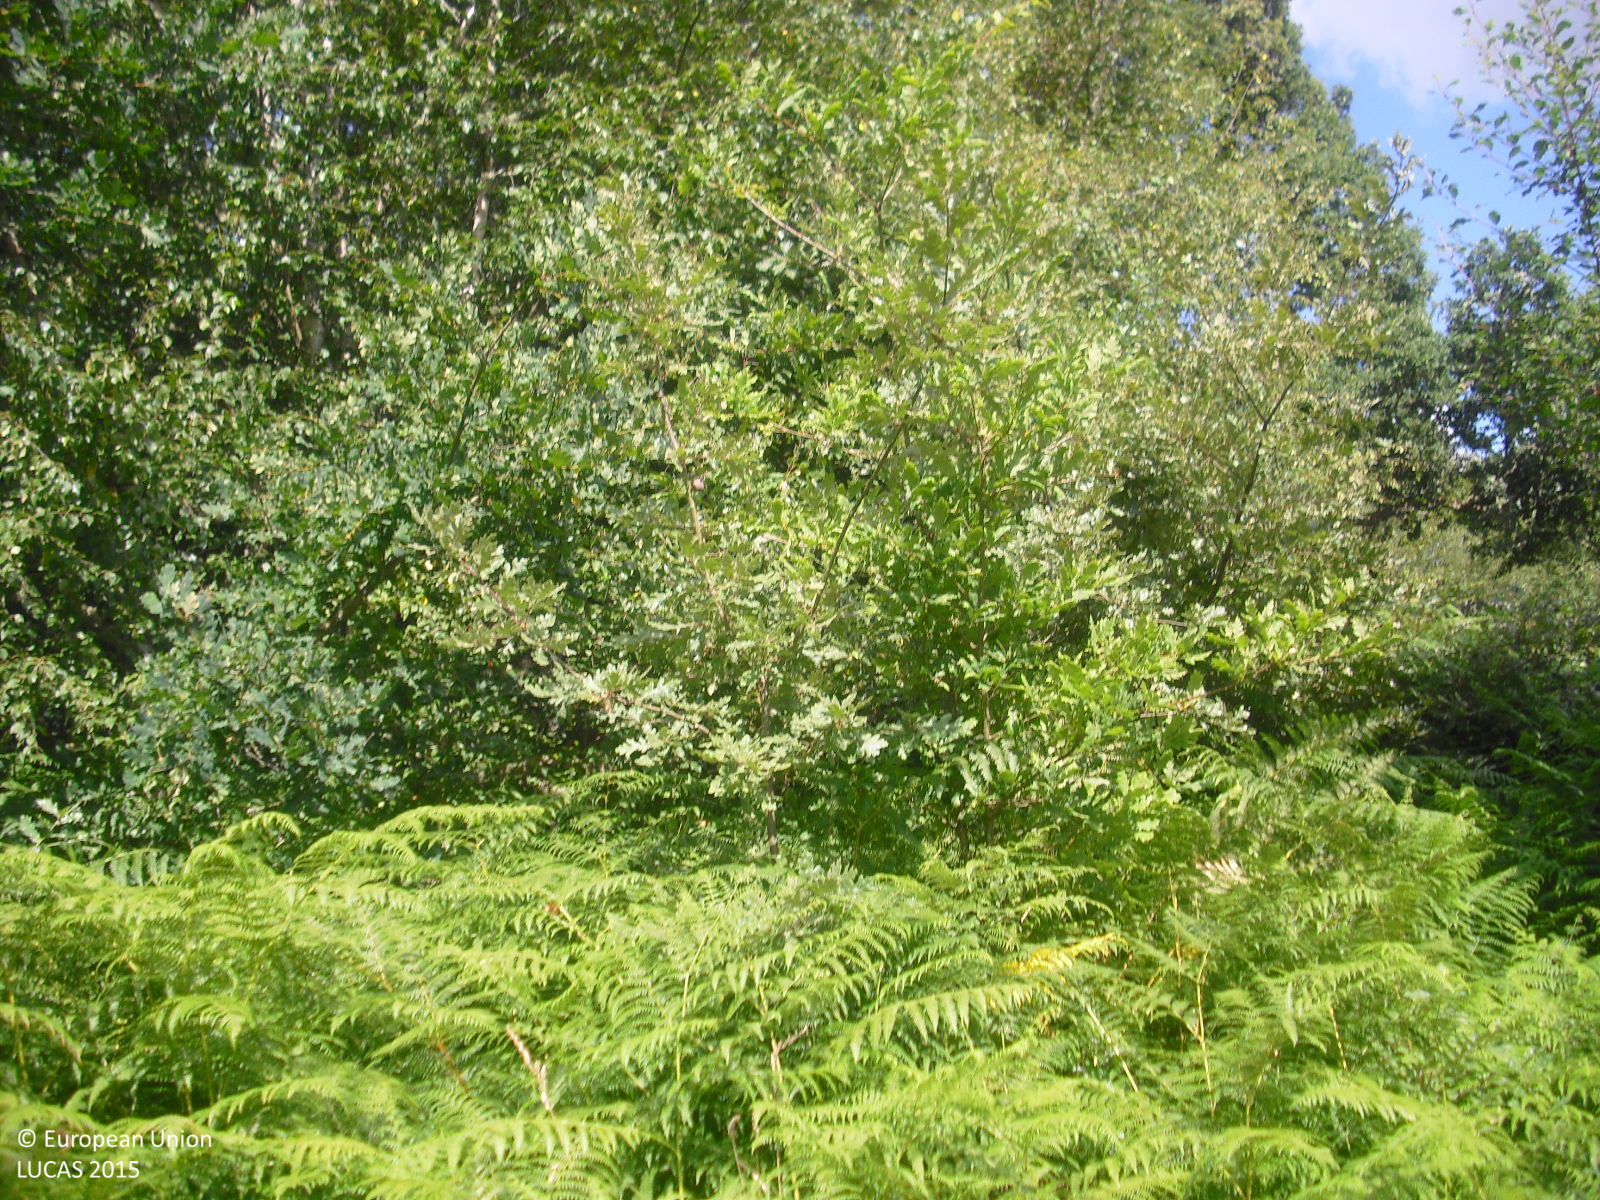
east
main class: Woodland
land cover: Broadleaved woodland
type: thermophilous deciduous forest
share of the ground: 50 - 75 %
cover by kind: broadleaved forest trees 60 %, shrubs 30 %, herbaceous plants 10 %
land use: Forestry
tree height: > 5 m
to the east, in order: Broadleaved woodland; Dry stone walls; Broadleaved woodland; Dry stone walls; Broadleaved woodland; Rivers and streams; Broadleaved woodland; Dry stone walls; Tracks; Dry stone walls; Broadleaved woodland; Shrubland without tree cover; Dry stone walls; Shrubland without tree cover; Rock outcrops; Dry stone walls; Shrubland with sparse tree cover; Rock outcrops; Shrubland without tree cover
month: July
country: ES
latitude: 42.3376
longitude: -7.6830
